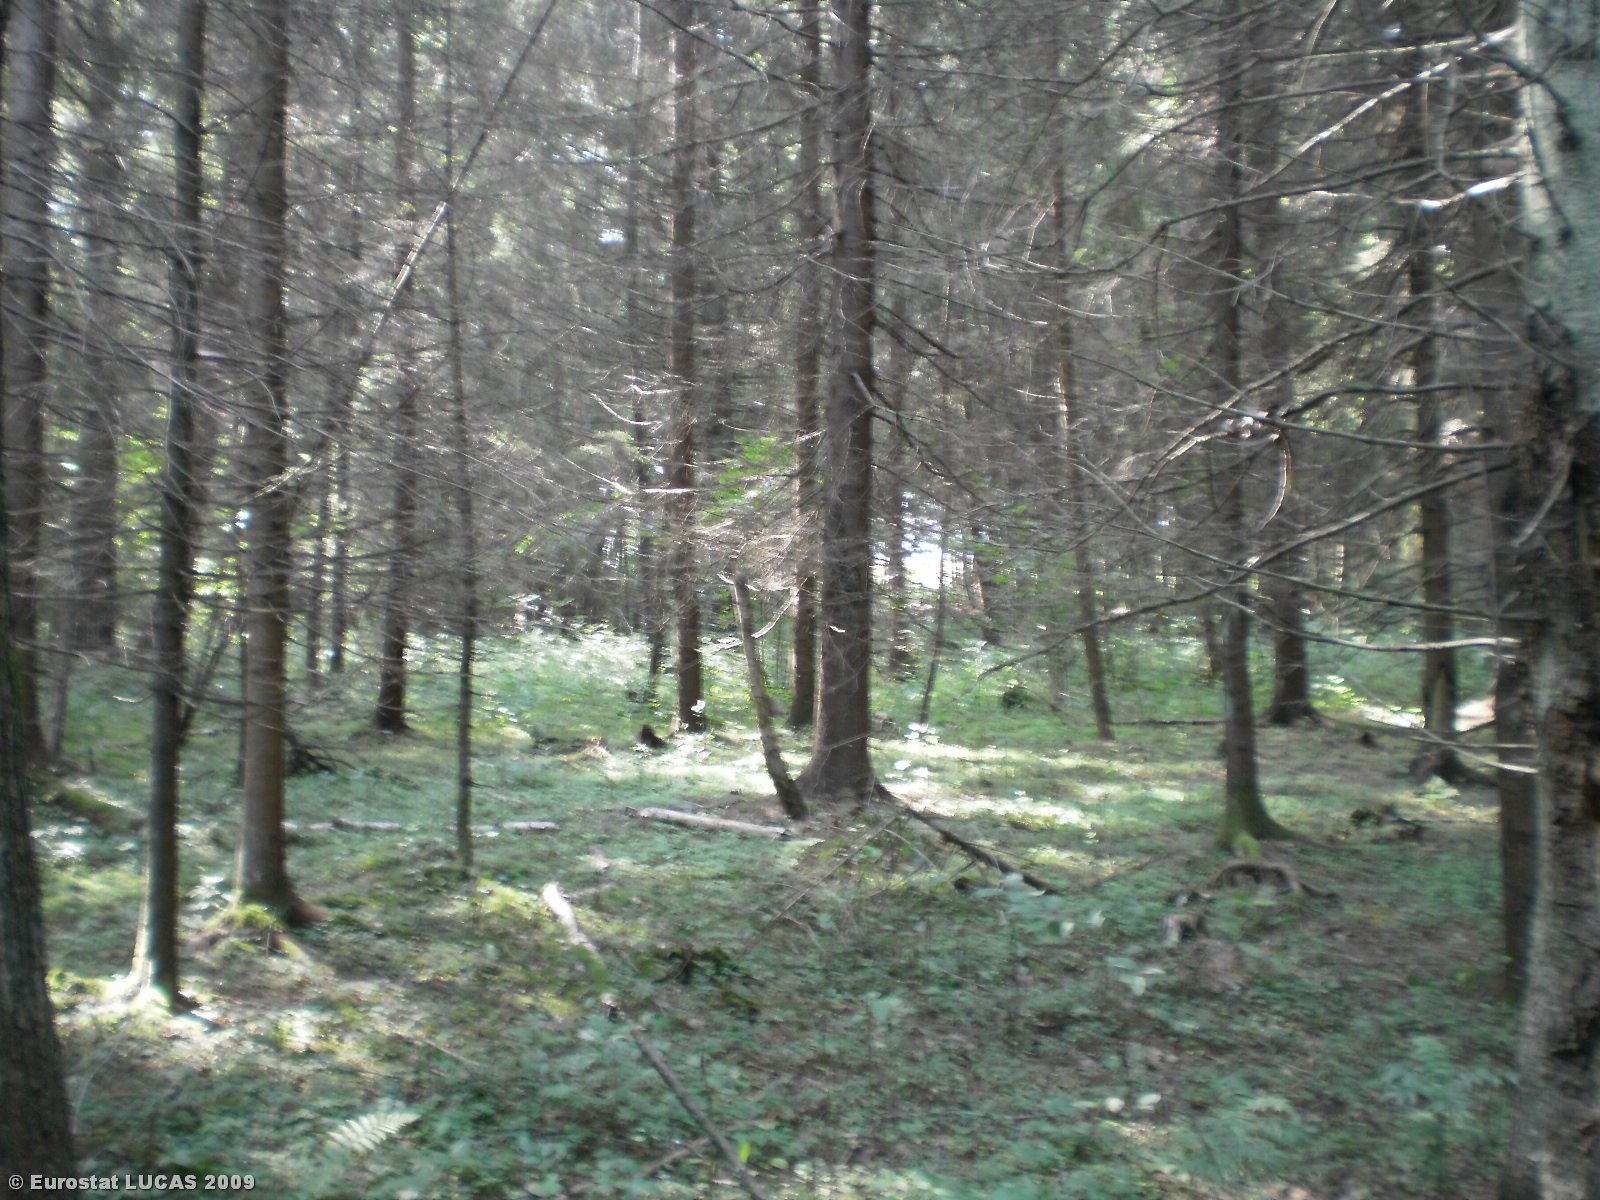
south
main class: Woodland
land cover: Coniferous woodland
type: hemiboreal forest and nemoral coniferous forest and mixed broadleaved-coniferous forest
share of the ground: > 75 %
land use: Forestry
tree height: > 5 m
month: July
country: LT
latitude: 55.8816
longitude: 25.7804
